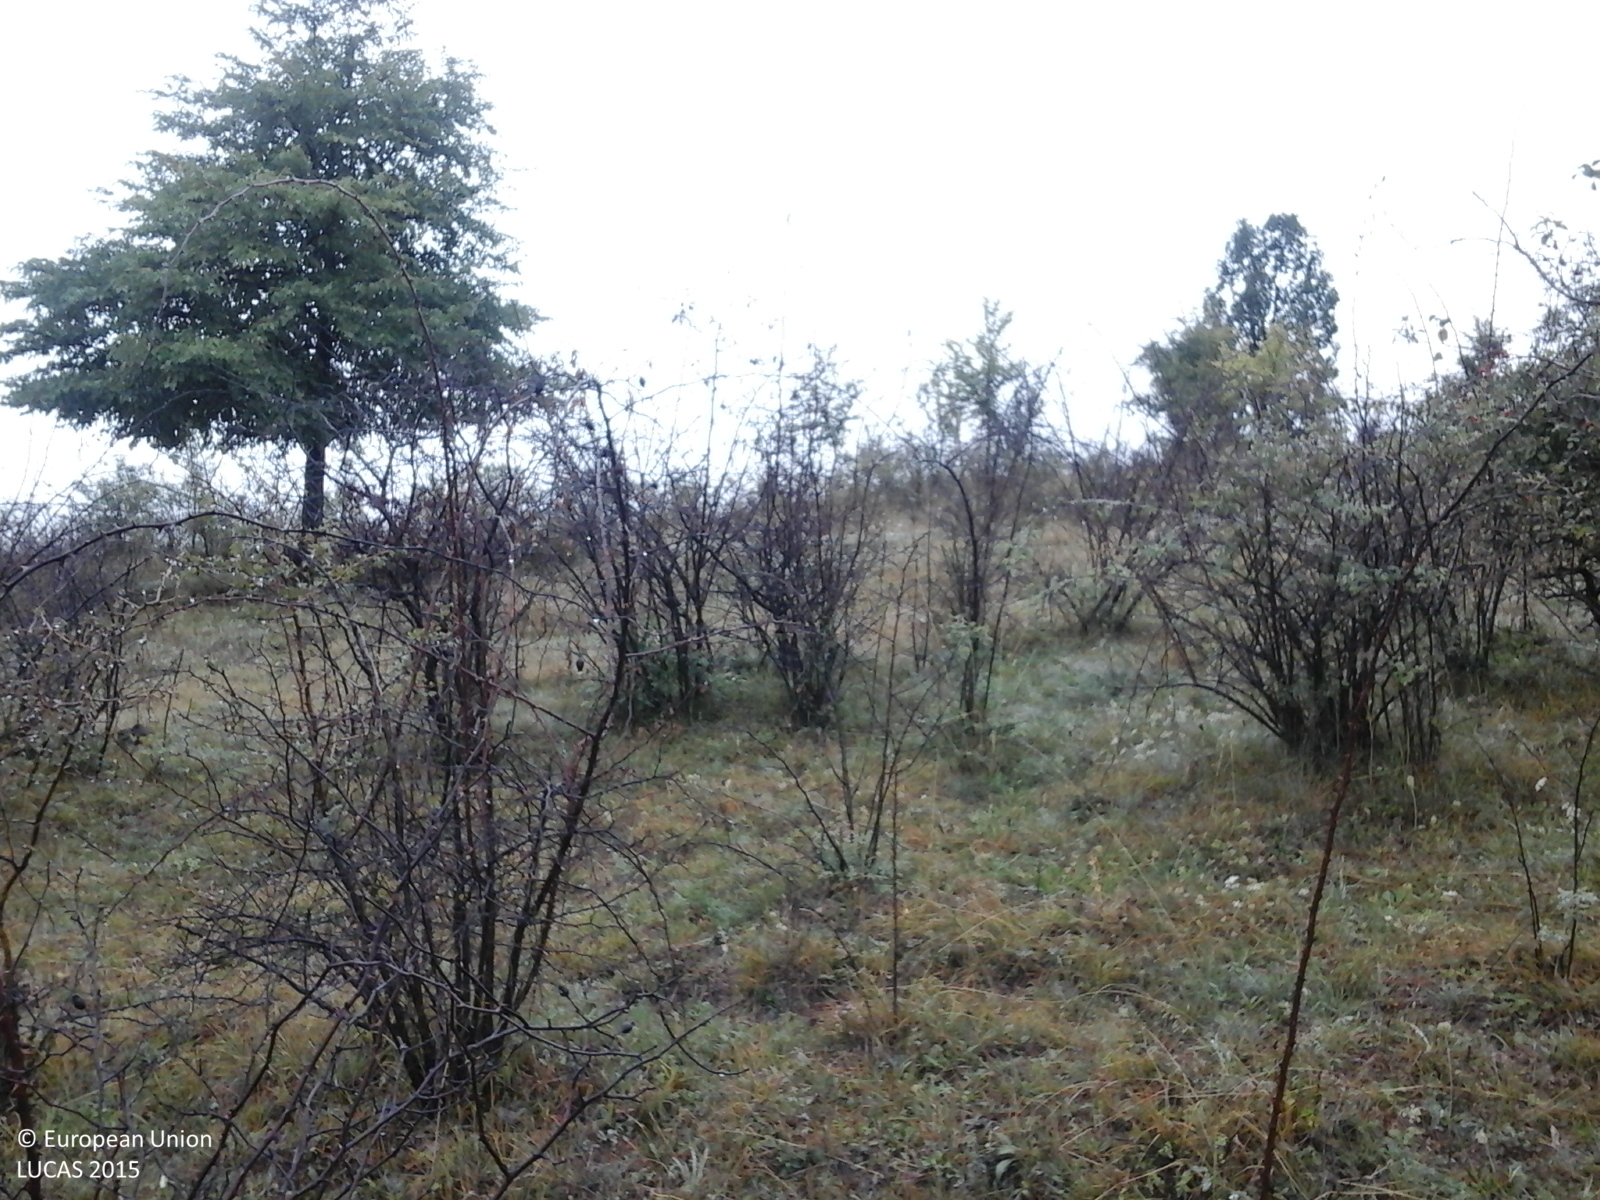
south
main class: Grassland
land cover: Grassland with sparse tree/shrub cover
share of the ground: > 75 %
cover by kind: herbaceous plants 85 %, shrubs 10 %, broadleaved forest trees 5 %
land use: Fallow land
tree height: < 5 m
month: September
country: RO
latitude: 44.9407
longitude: 23.6574
